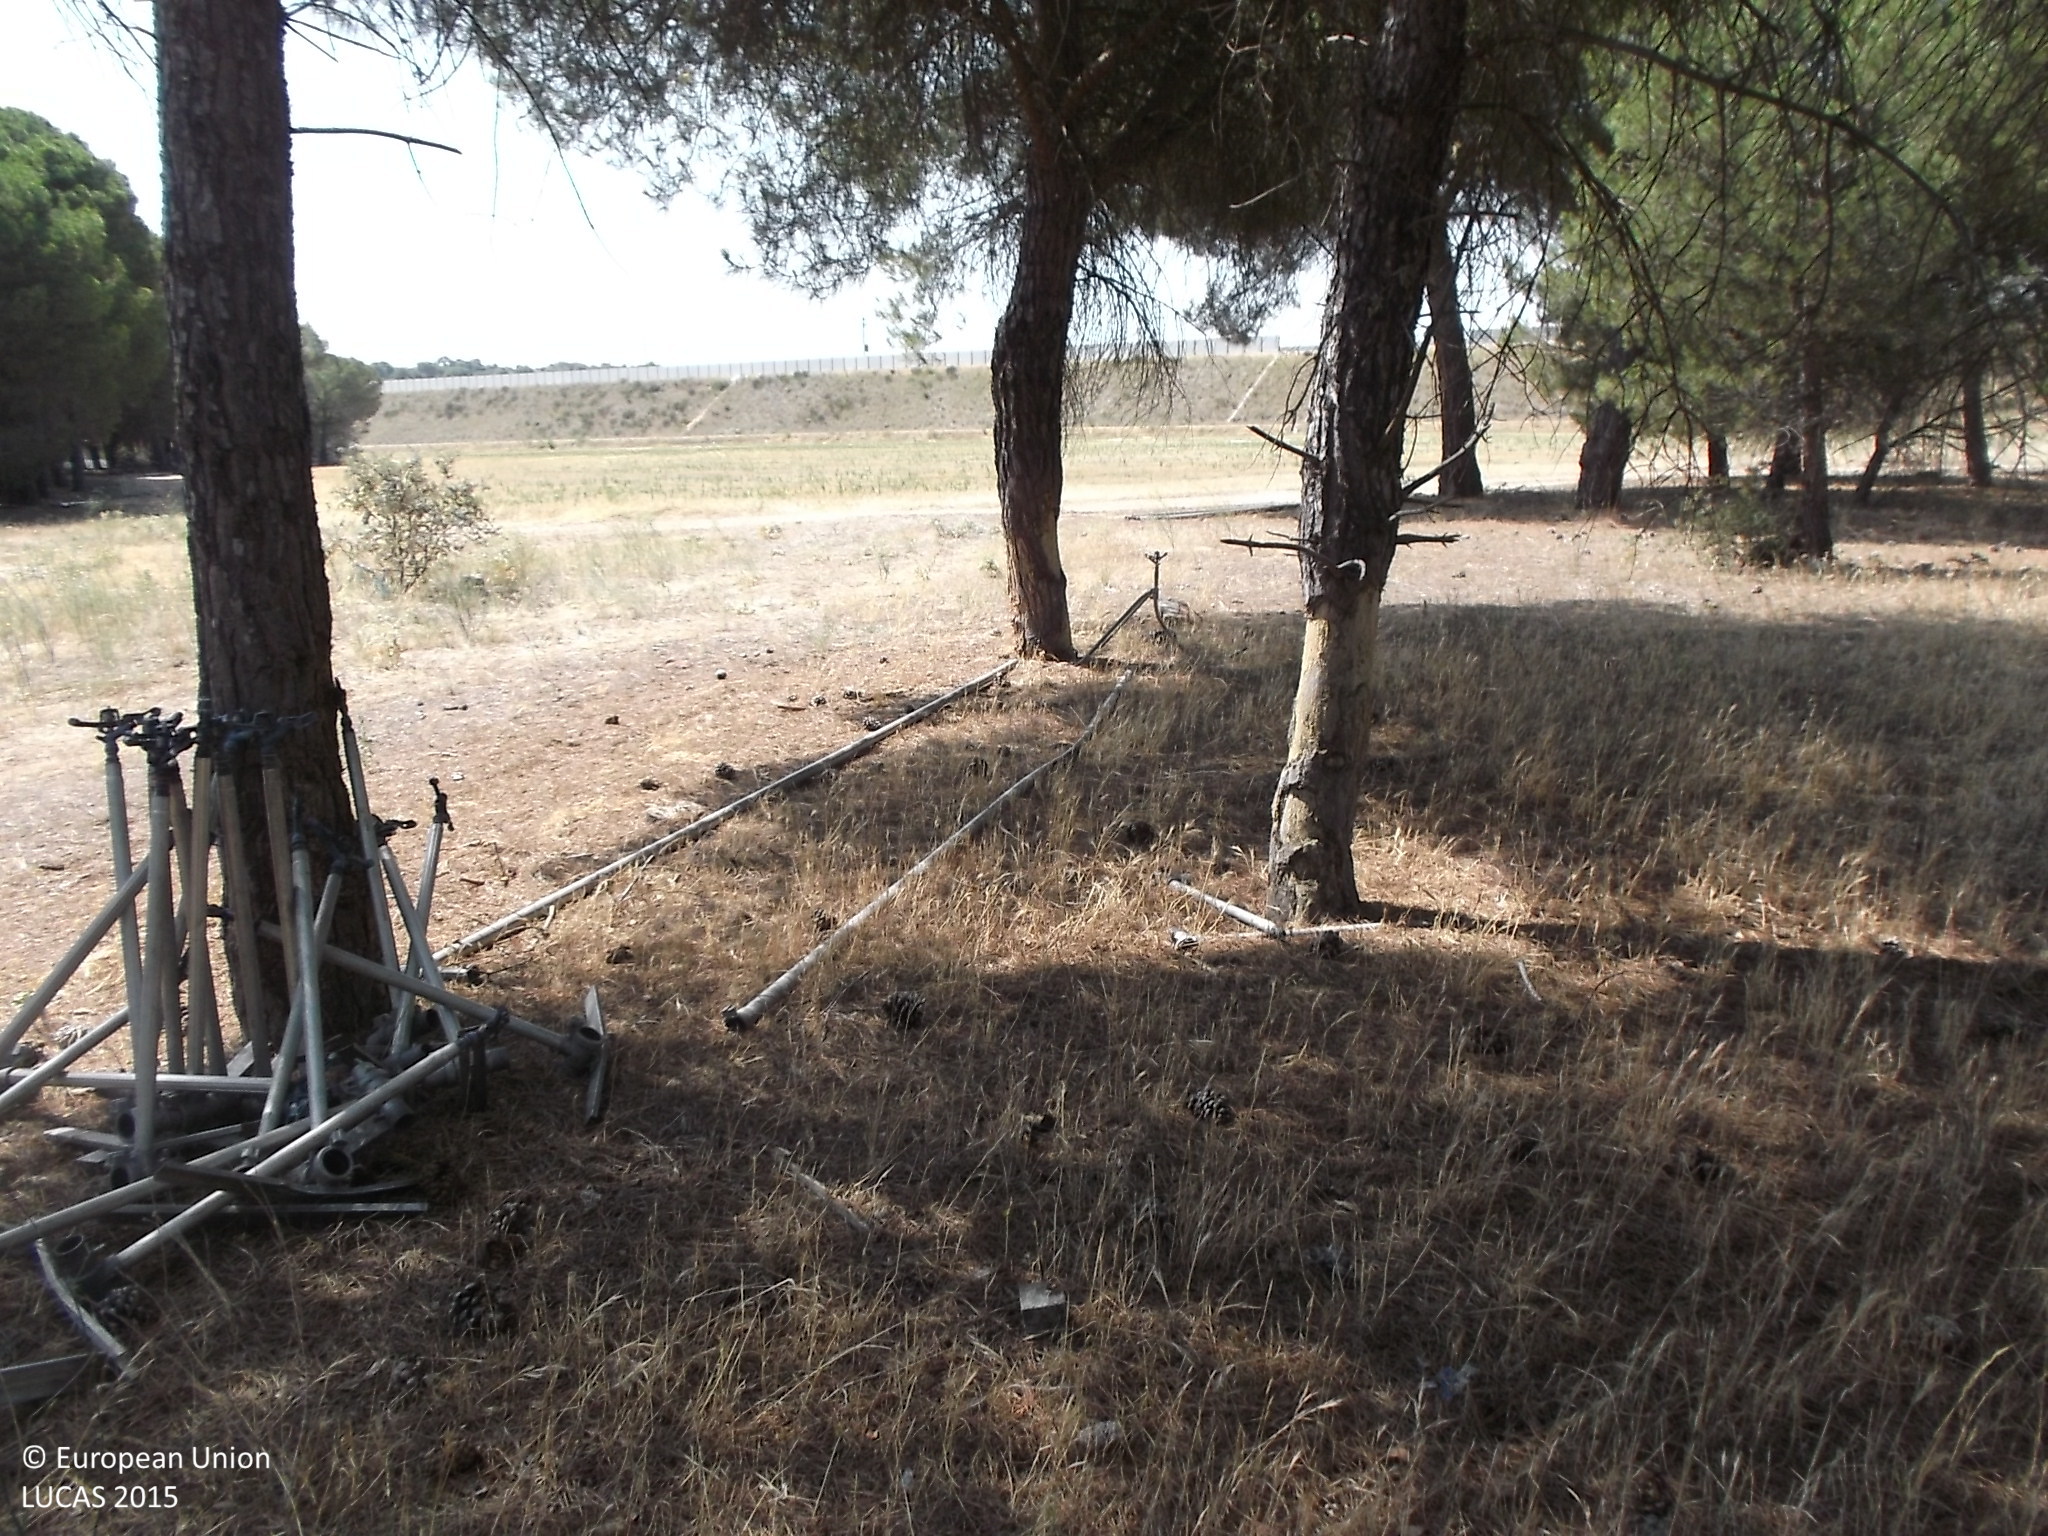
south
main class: Woodland
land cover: Pine dominated coniferous woodland
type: coniferous forest of the mediterranean region
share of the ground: > 75 %
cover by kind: coniferous forest trees 90 %, herbaceous plants 10 %
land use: Forestry
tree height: < 5 m
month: July
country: ES
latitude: 41.4691
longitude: -5.3935
